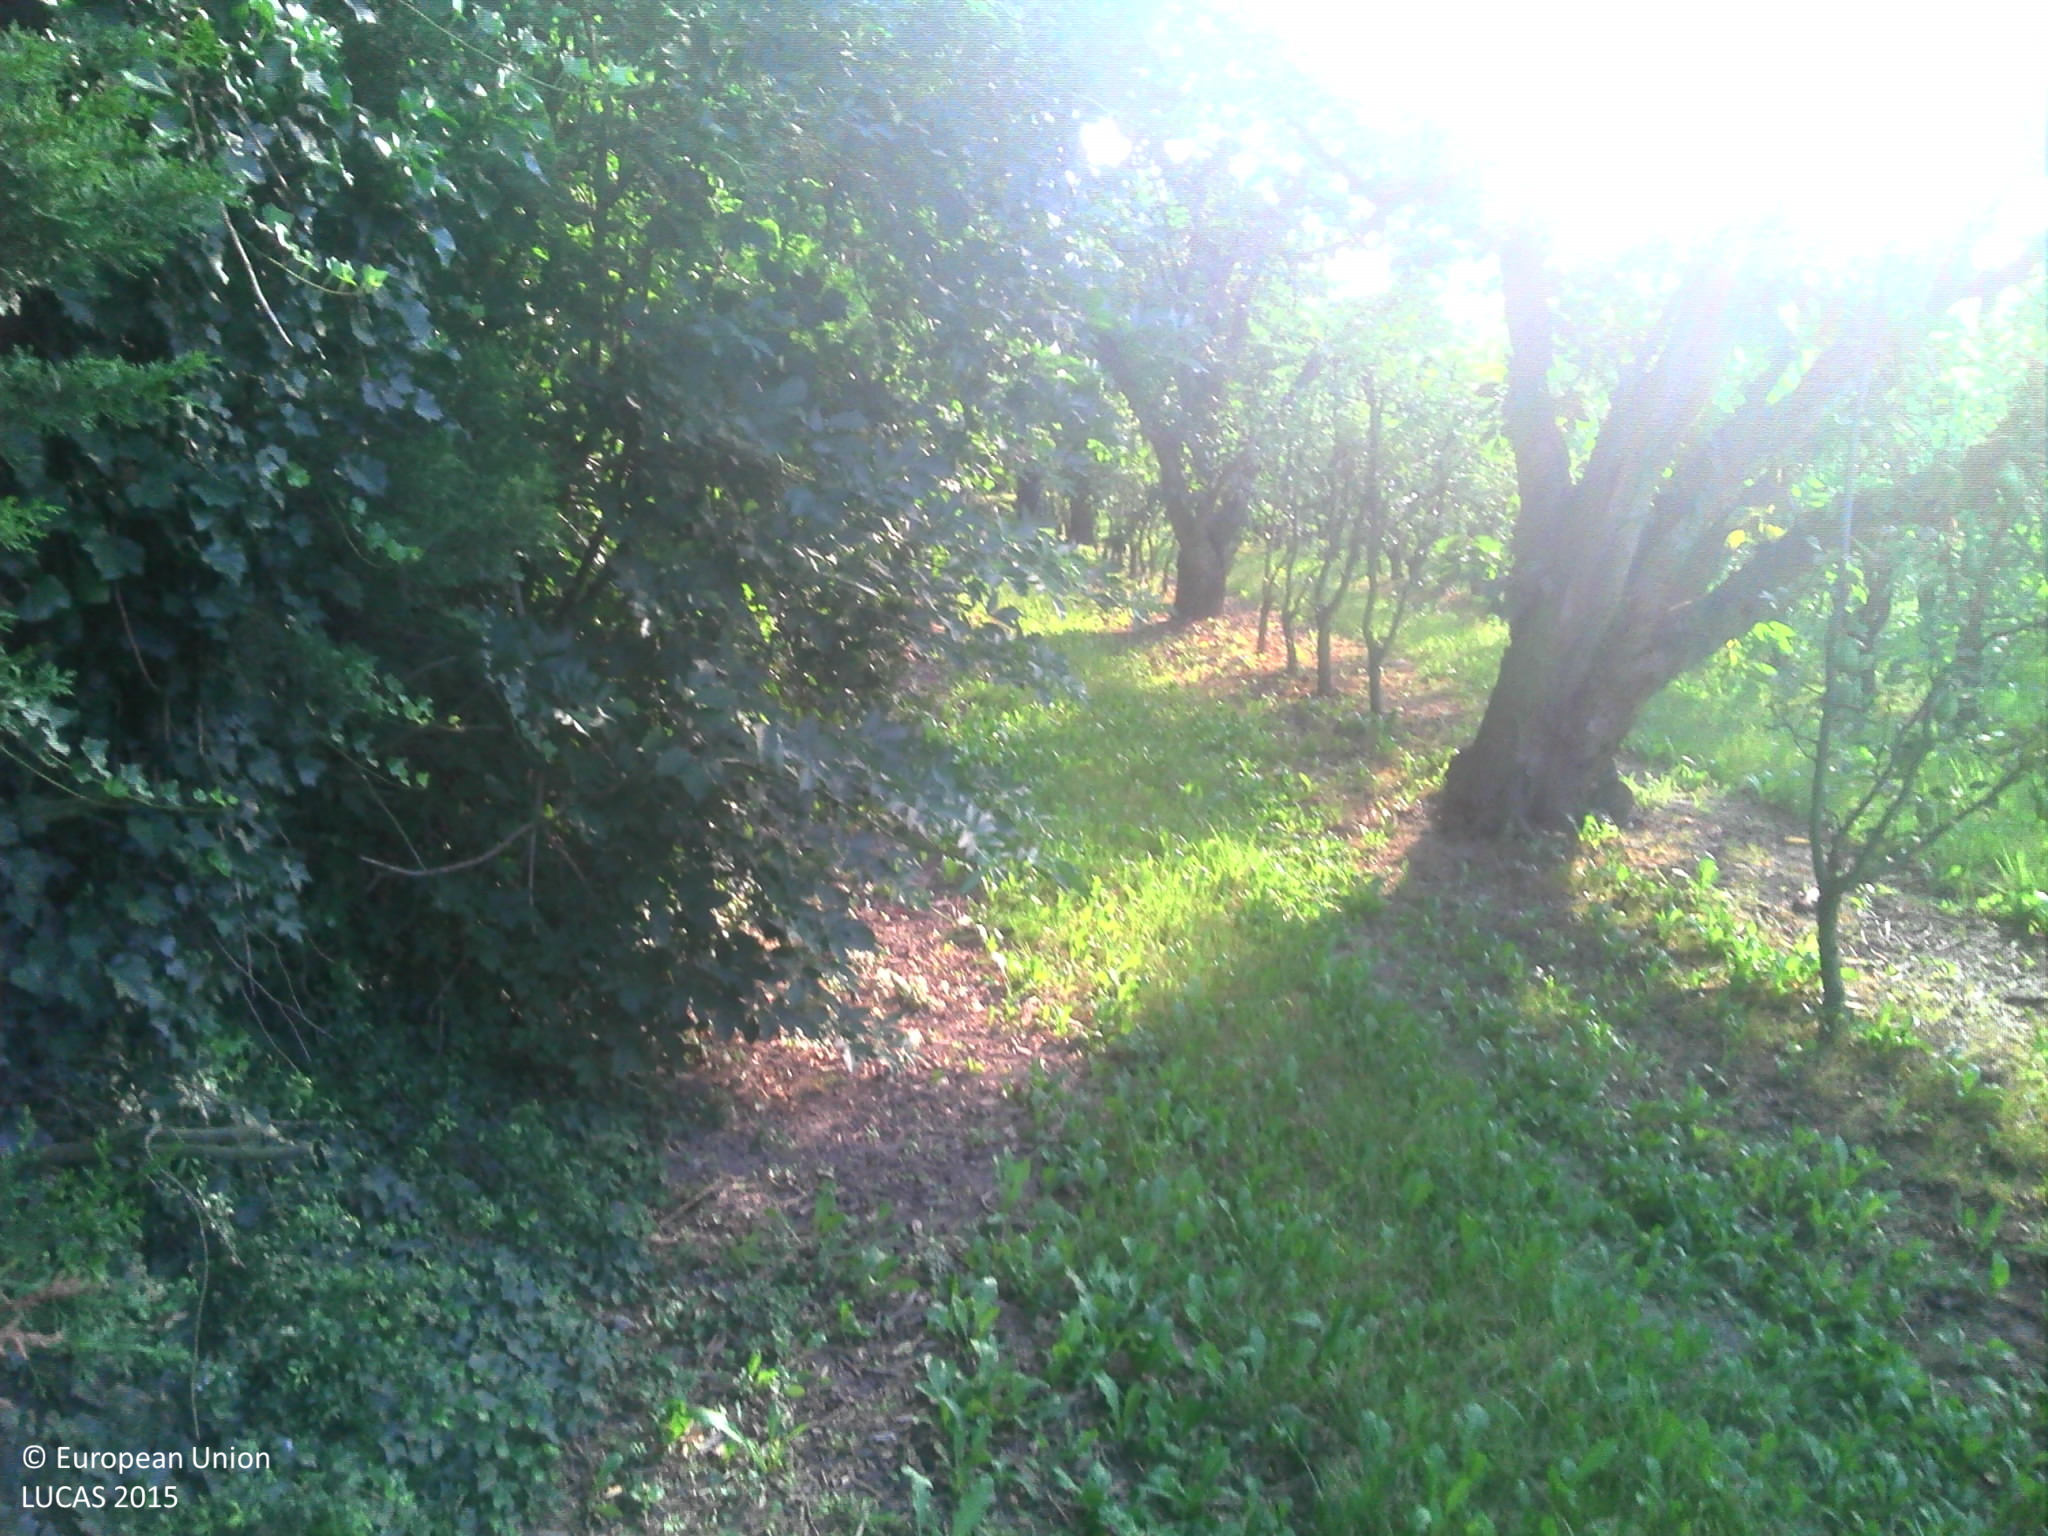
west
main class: Cropland
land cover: Pear fruit
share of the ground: > 75 %
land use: Agriculture (excluding fallow land and kitchen gardens)
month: July
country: FR
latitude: 43.7640
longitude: 5.0777
